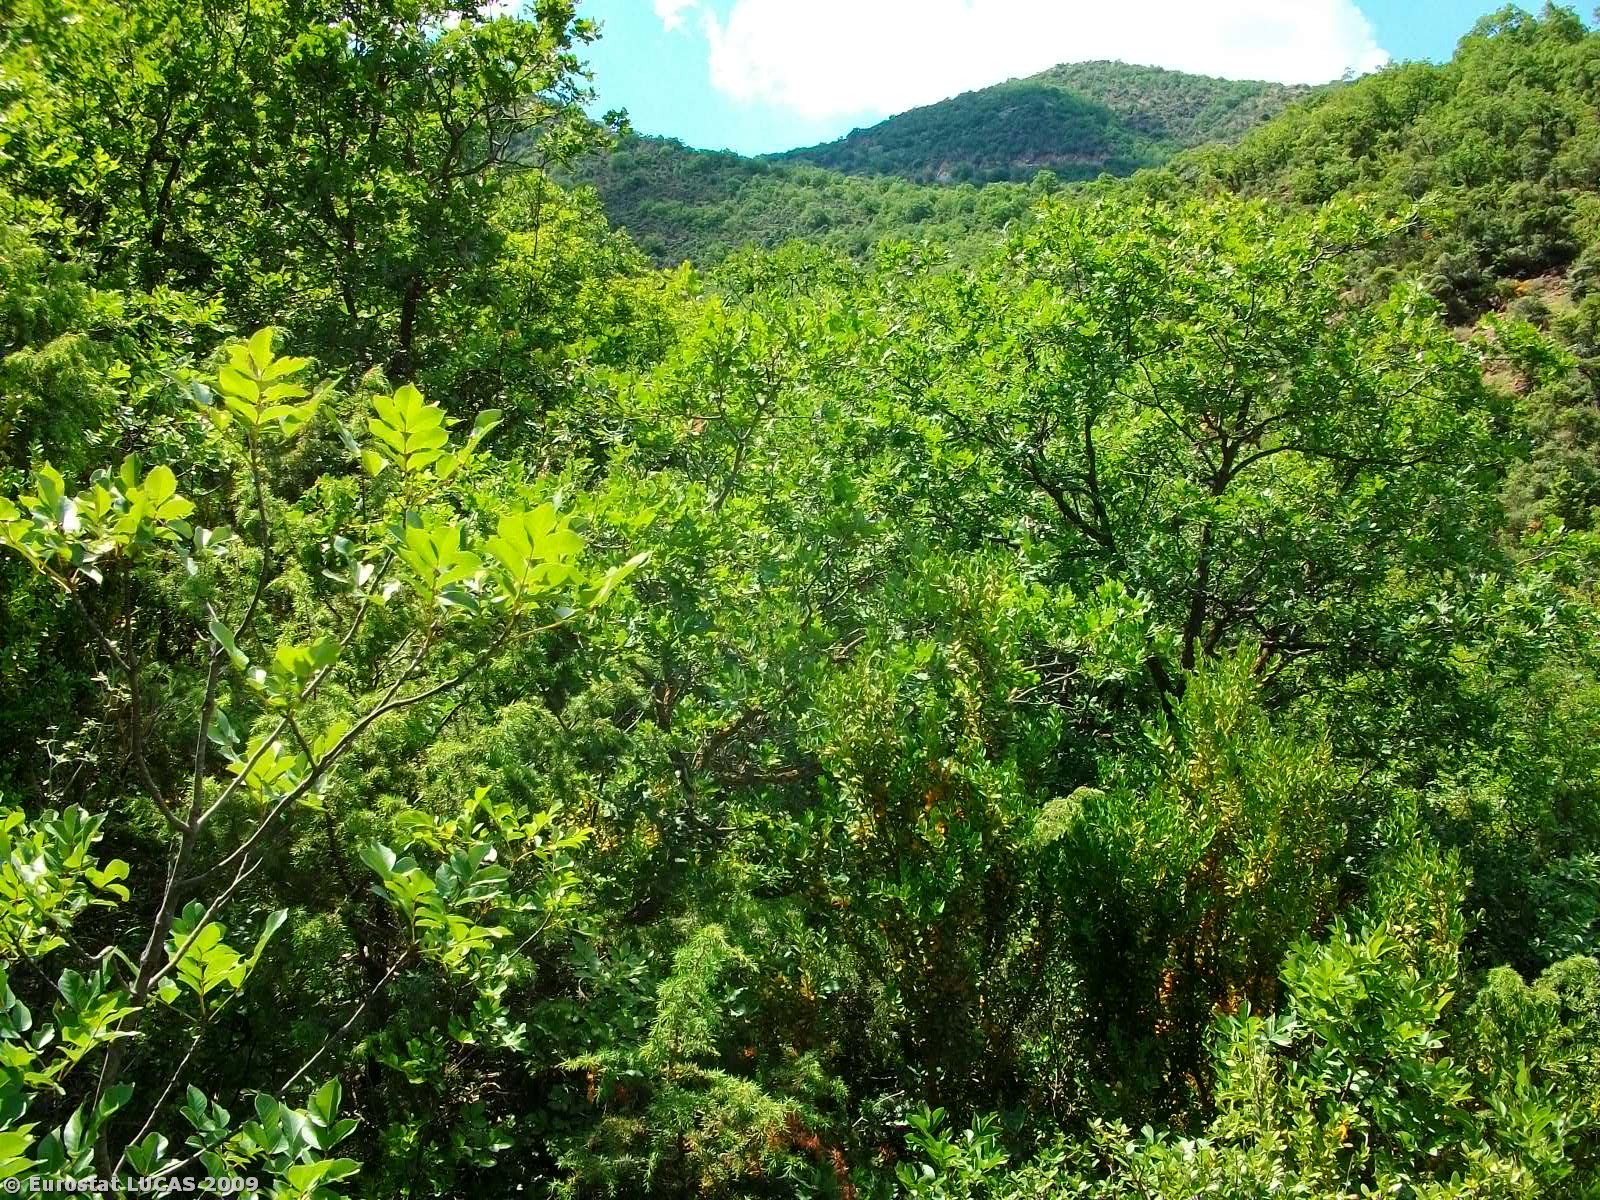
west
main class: Woodland
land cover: Broadleaved woodland
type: thermophilous deciduous forest
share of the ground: > 75 %
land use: Forestry
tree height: > 5 m
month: June
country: GR
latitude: 40.0495
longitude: 21.7693
